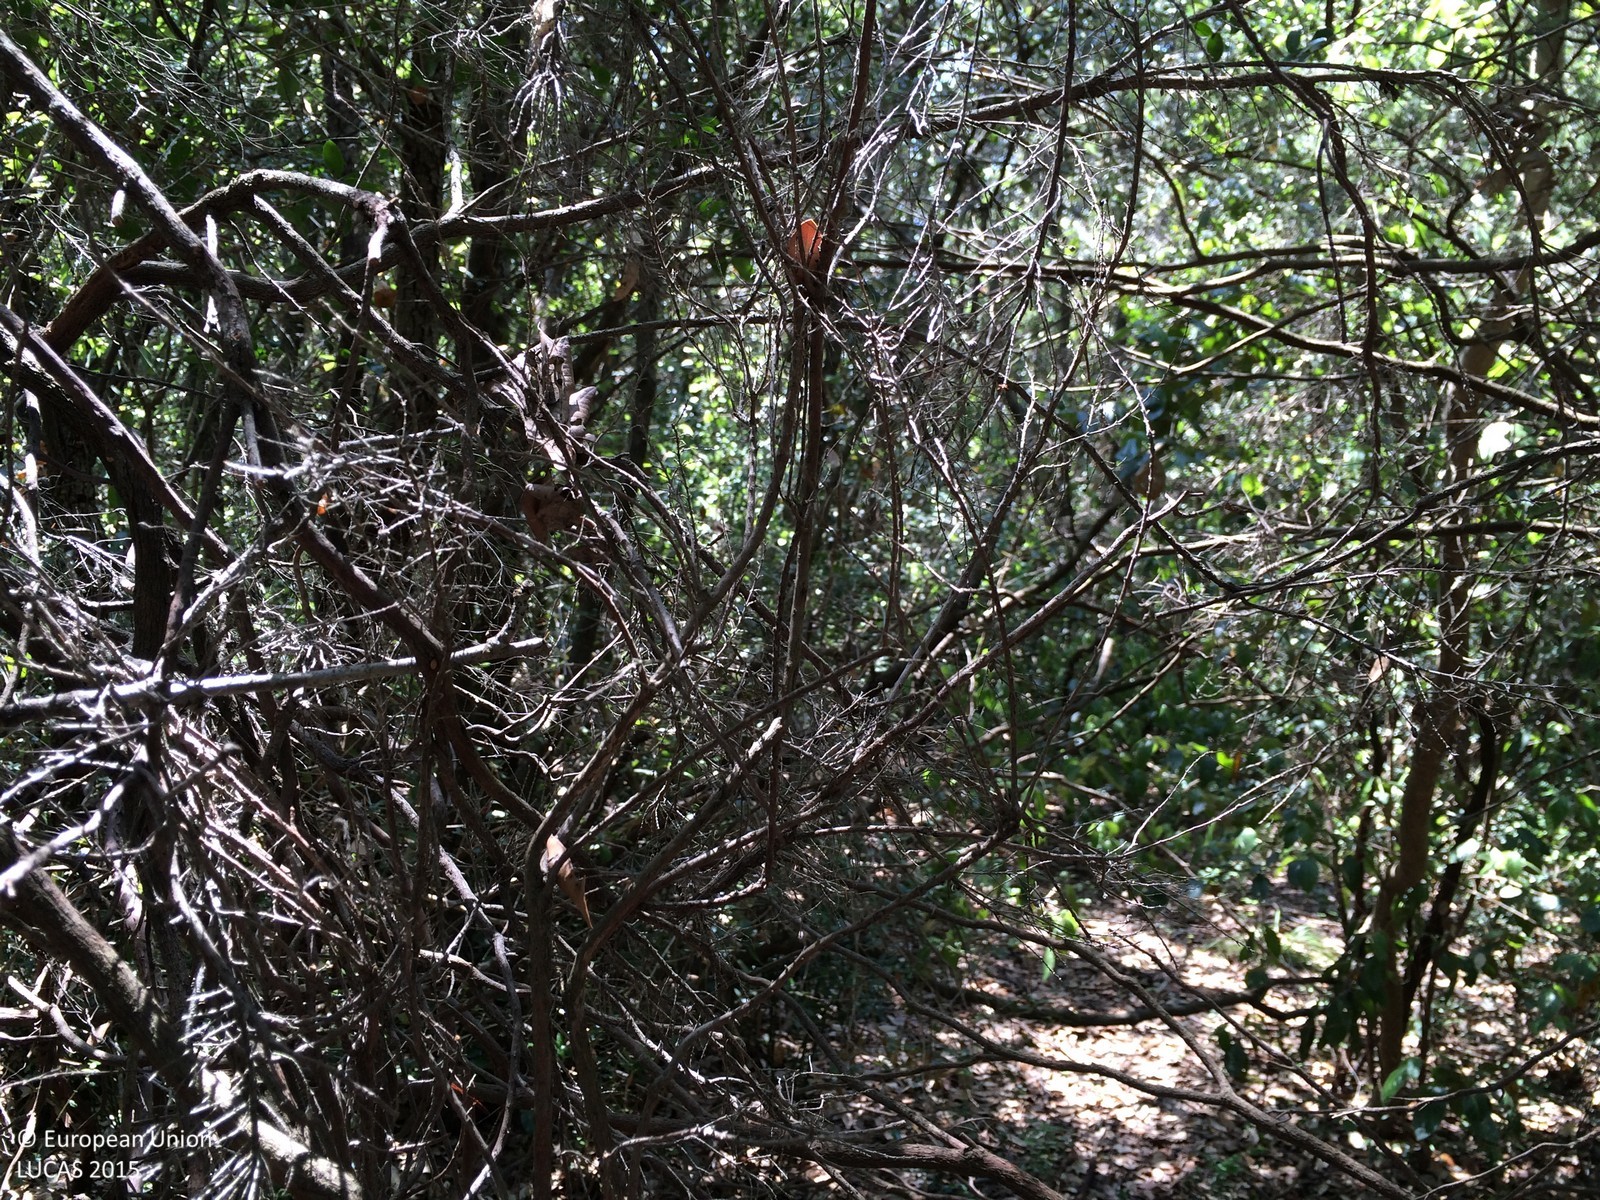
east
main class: Woodland
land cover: Broadleaved woodland
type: broadleaved evergreen forest
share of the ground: > 75 %
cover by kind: broadleaved forest trees 95 %, shrubs 5 %
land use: Semi-natural and natural areas not in use
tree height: > 5 m
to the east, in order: Broadleaved woodland; Tracks; Other bare soil; Shrubland without tree cover; Broadleaved woodland
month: June
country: HR
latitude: 44.9580
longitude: 14.0380
